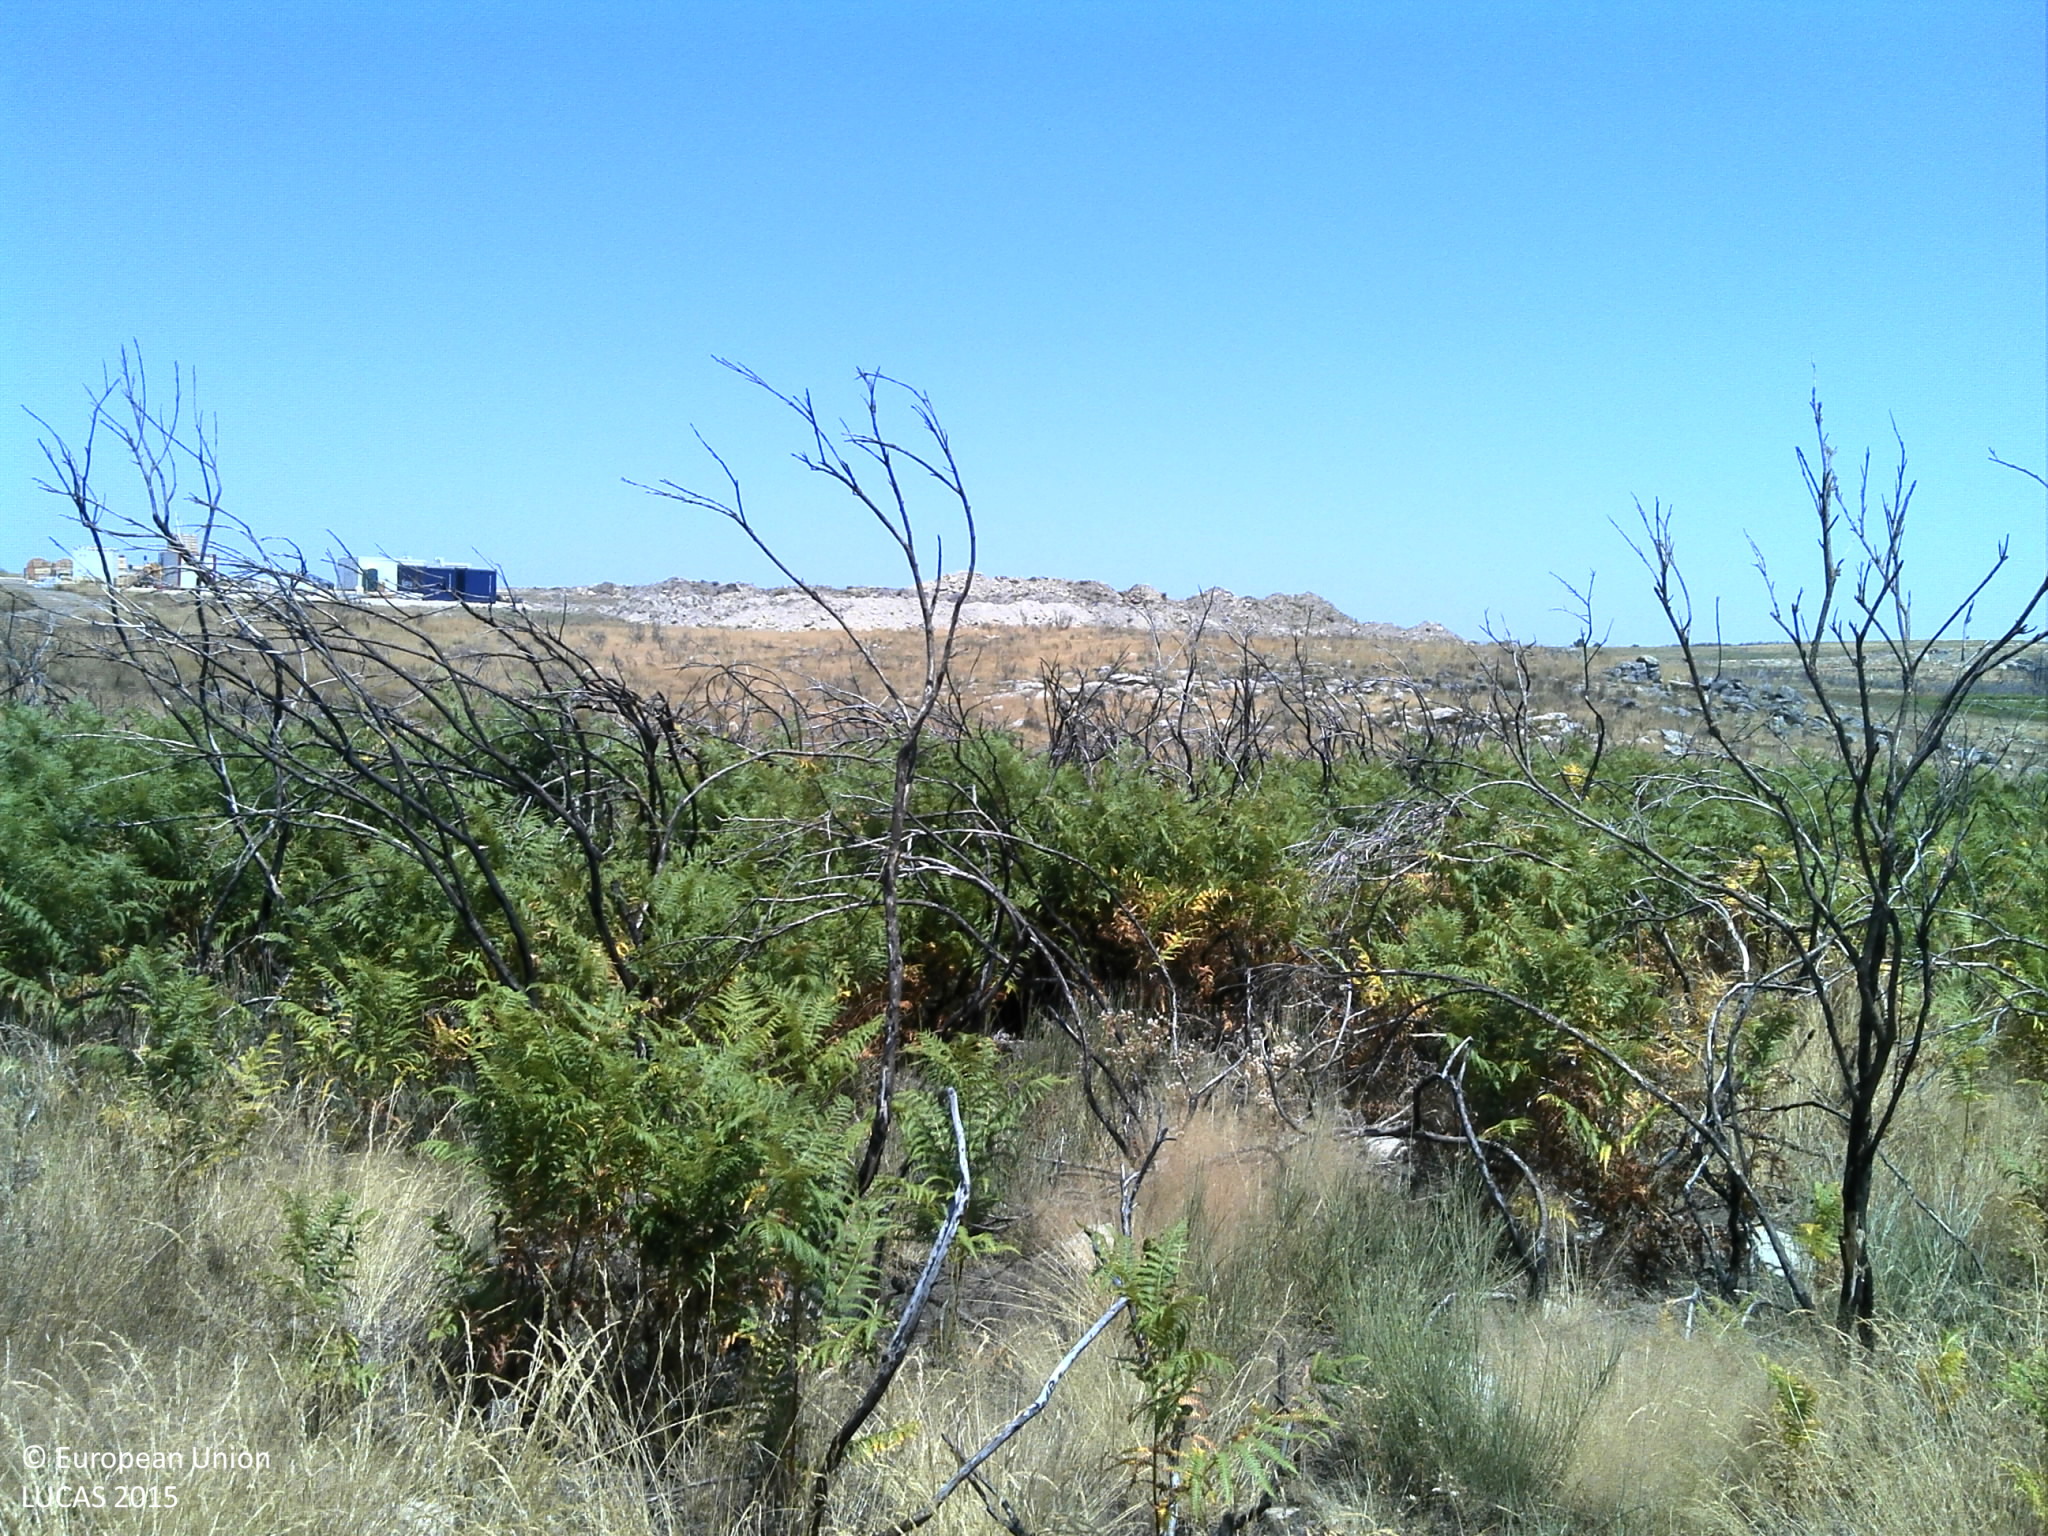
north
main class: Grassland
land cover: Grassland without tree/shrub cover
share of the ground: 50 - 75 %
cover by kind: herbaceous plants 60 %, consolidated bare surface 20 %, unconsolidated bare surface 15 %, shrubs 5 %
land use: Semi-natural and natural areas not in use
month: July
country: PT
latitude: 40.8754
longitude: -7.4038
